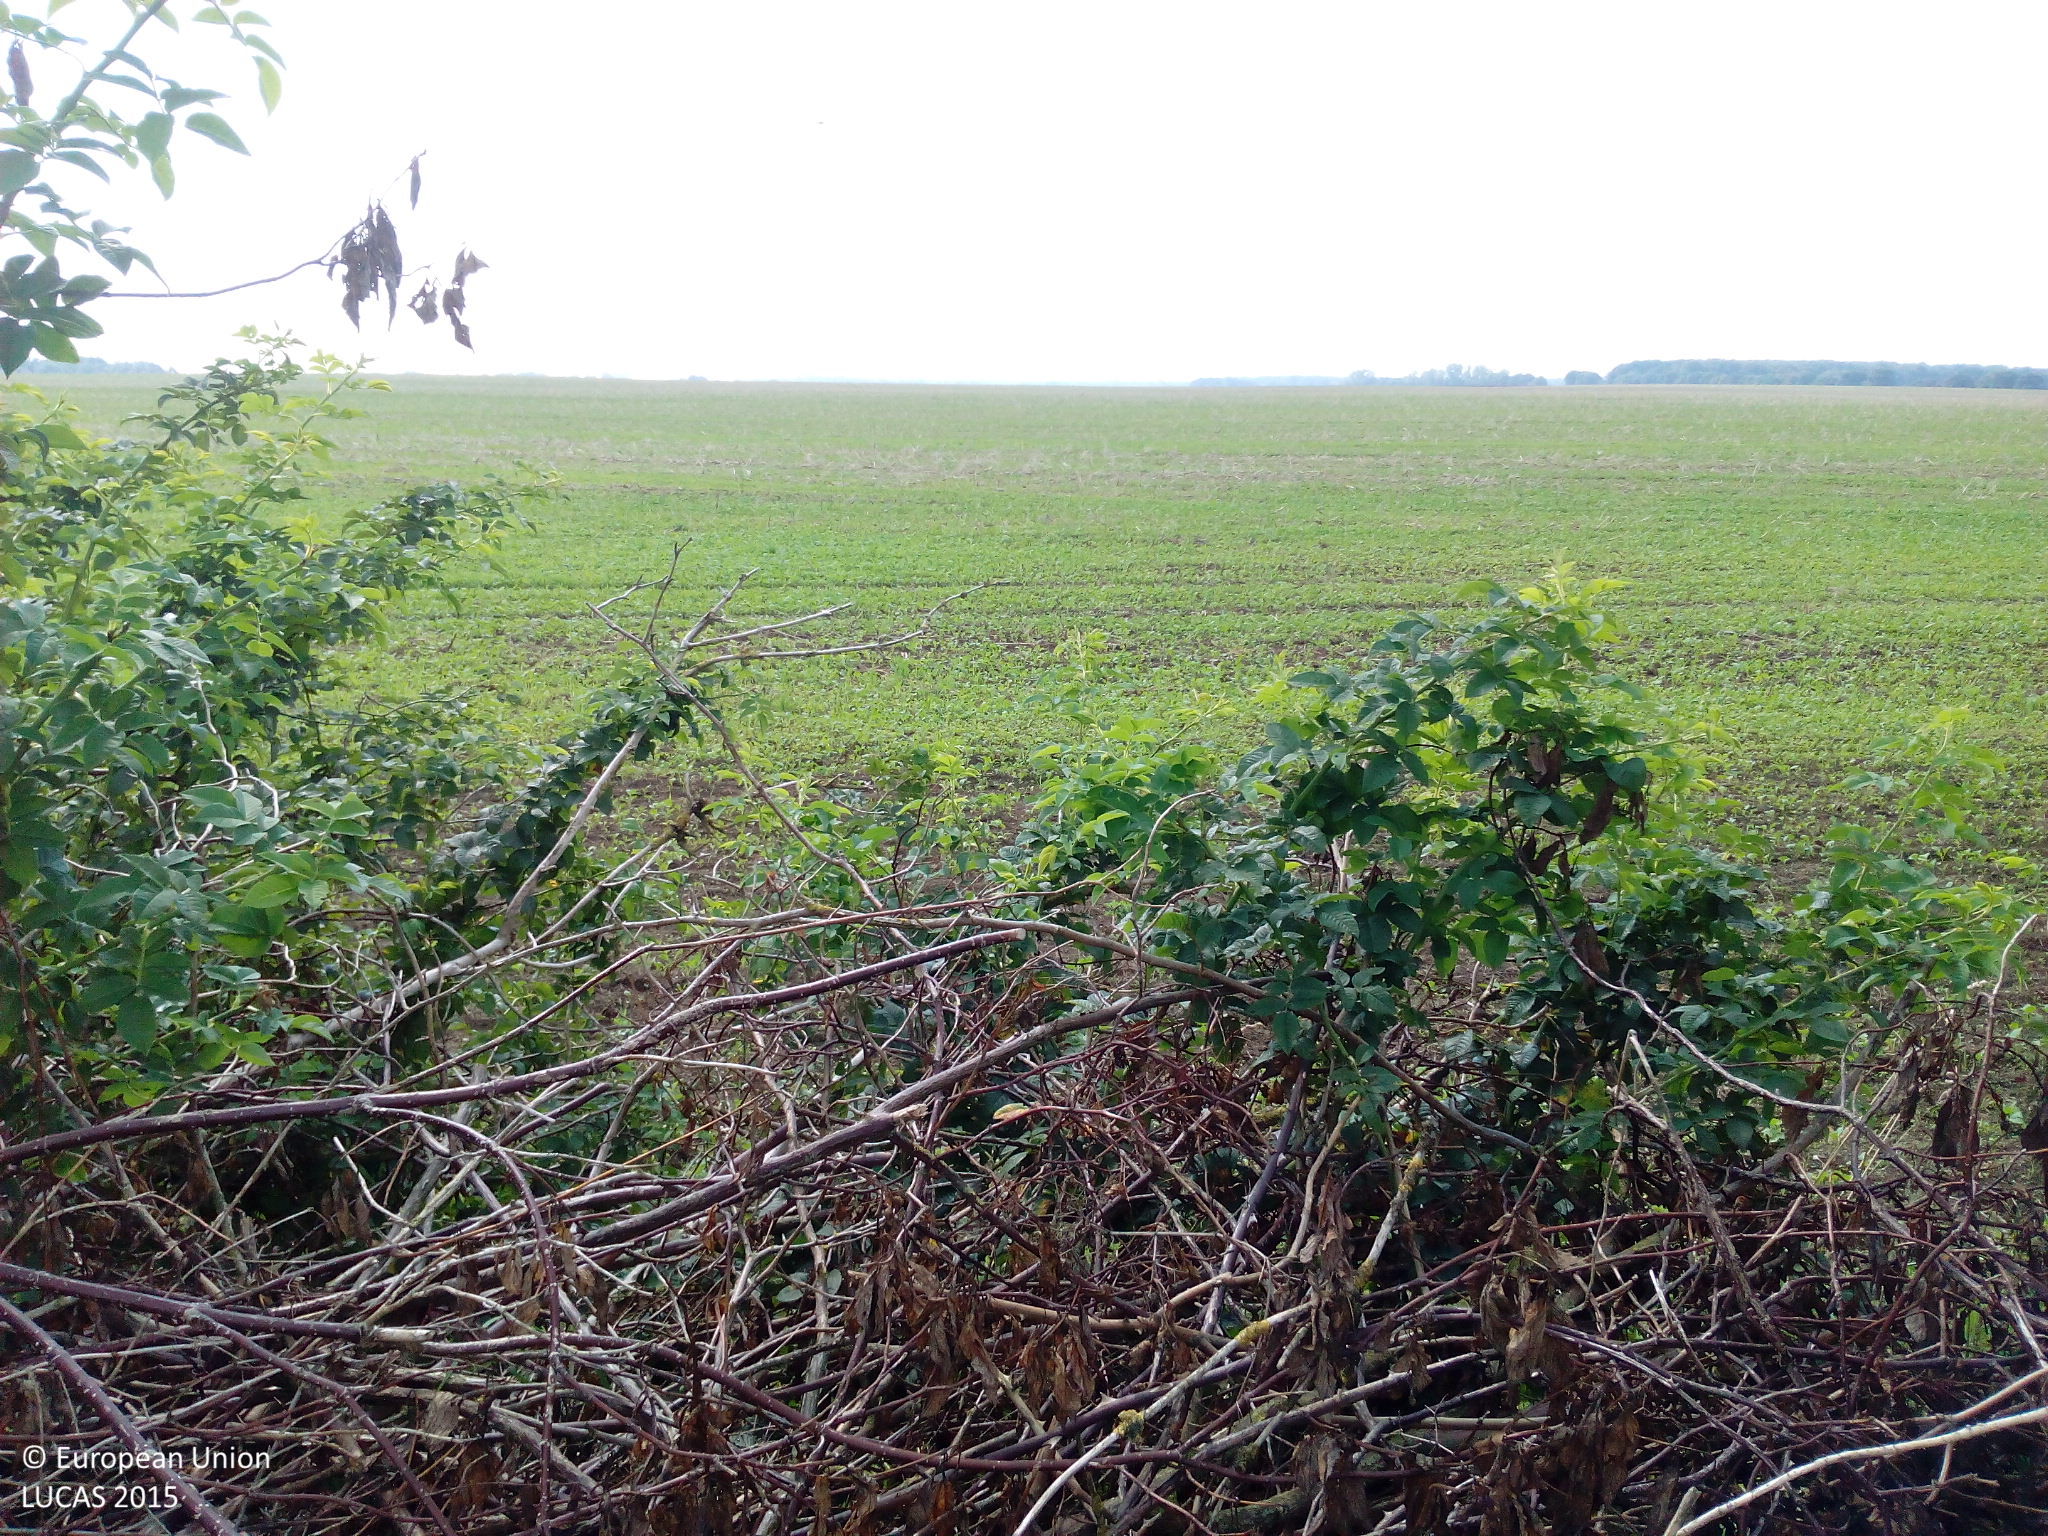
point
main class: Cropland
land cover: Rape and turnip rape
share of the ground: 10 - 25 %
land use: Agriculture (excluding fallow land and kitchen gardens)
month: August
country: DE
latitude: 54.2008
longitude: 12.6204
